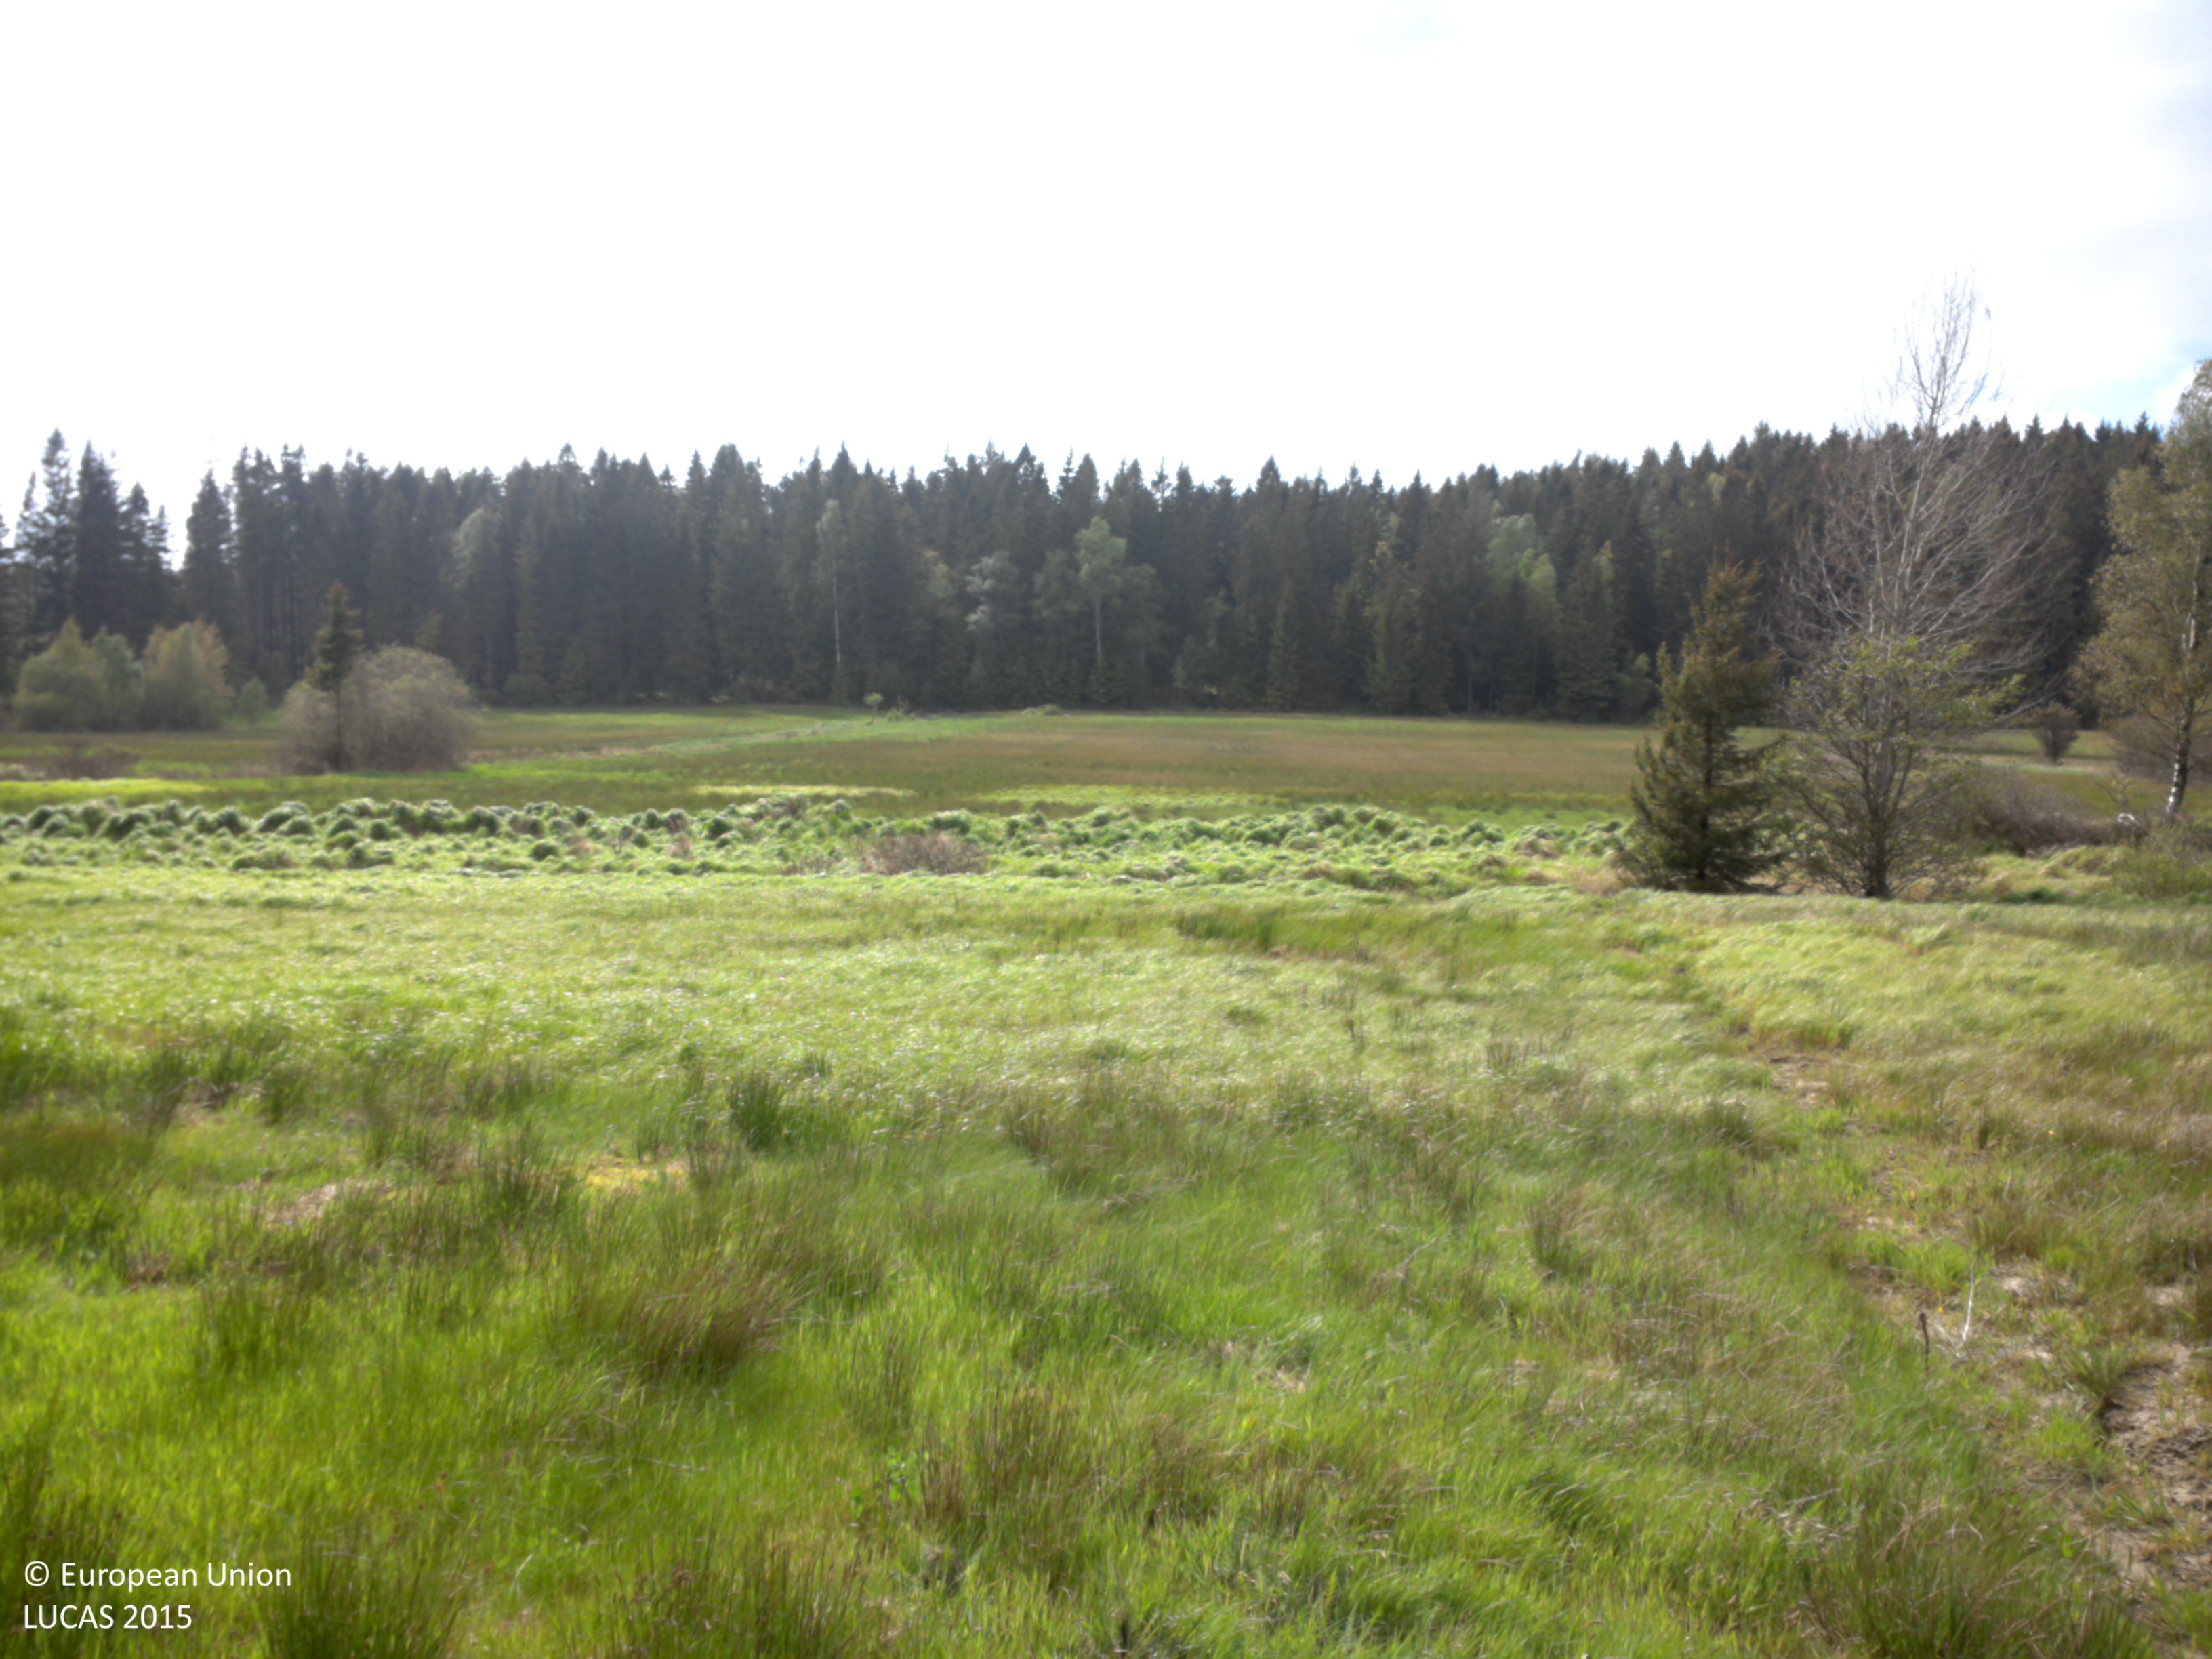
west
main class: Grassland
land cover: Grassland without tree/shrub cover
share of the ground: > 75 %
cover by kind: herbaceous plants 100 %
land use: Agriculture (excluding fallow land and kitchen gardens)
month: June
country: SE
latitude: 58.1693
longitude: 11.9512
